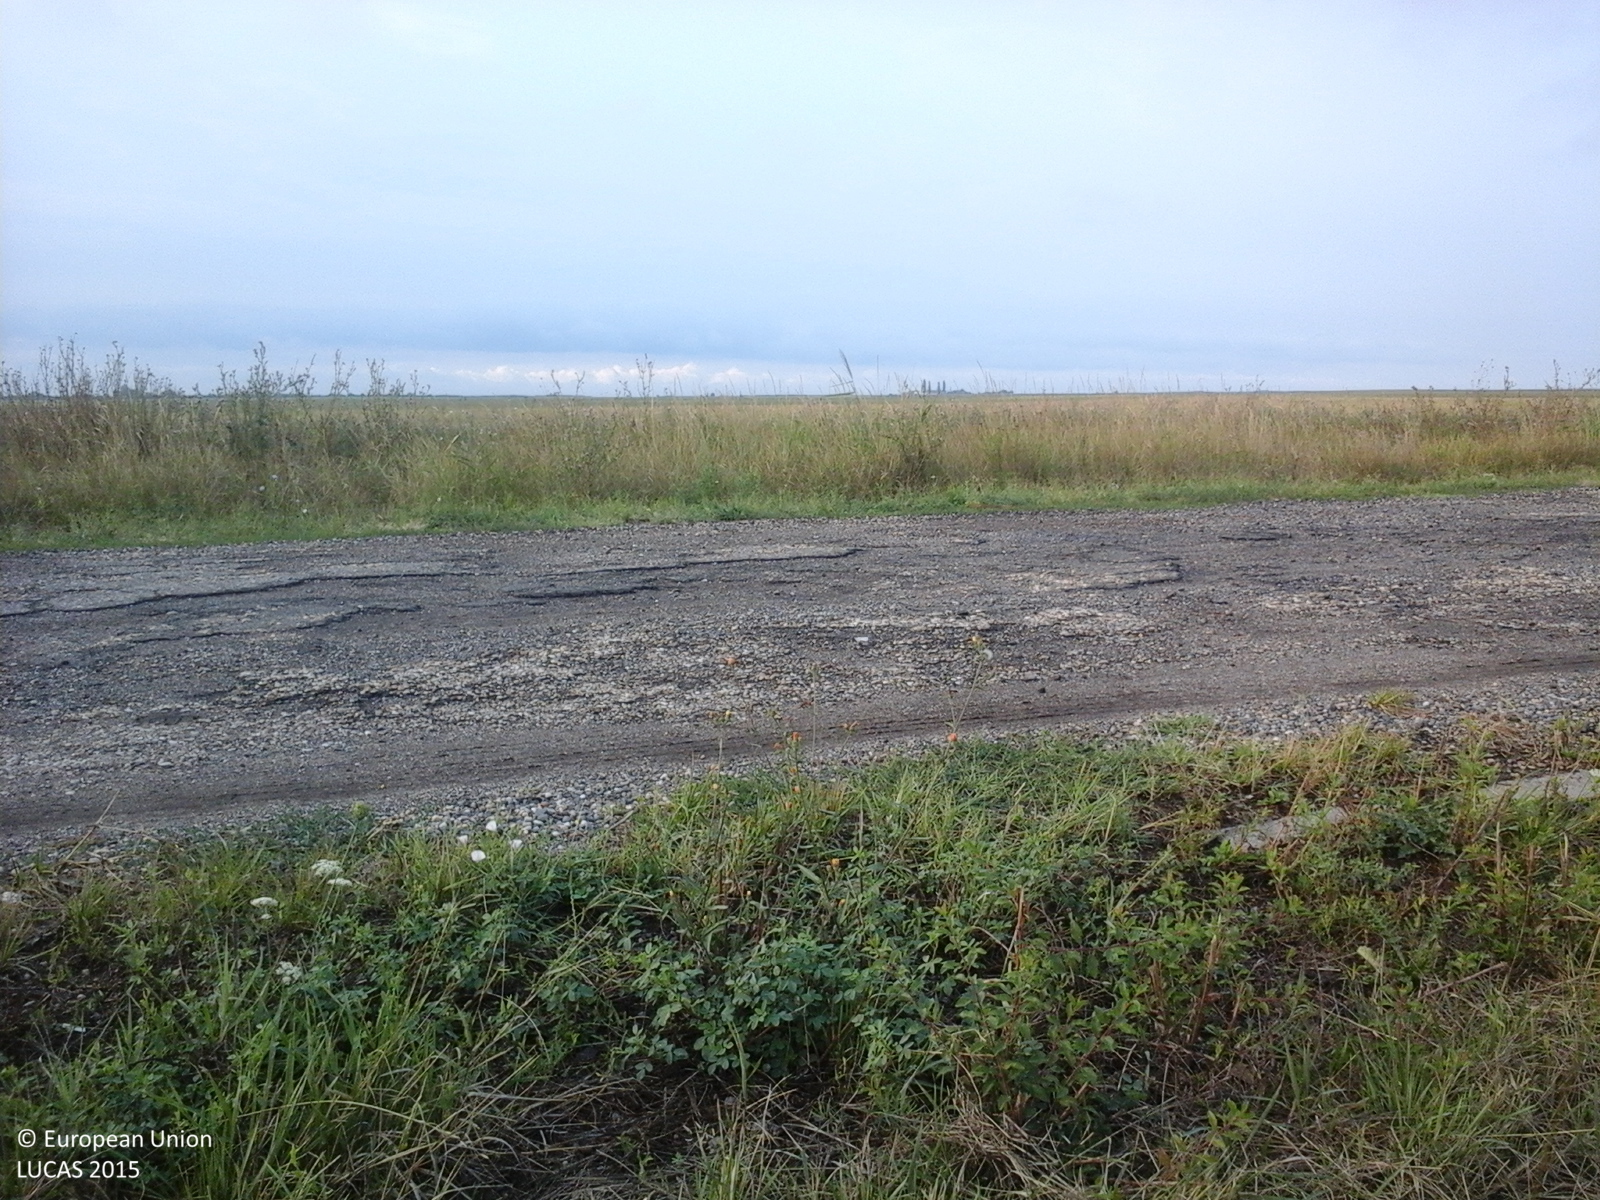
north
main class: Cropland
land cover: Sunflower
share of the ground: > 75 %
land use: Agriculture (excluding fallow land and kitchen gardens)
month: August
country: RO
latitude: 45.9916
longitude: 20.3640
